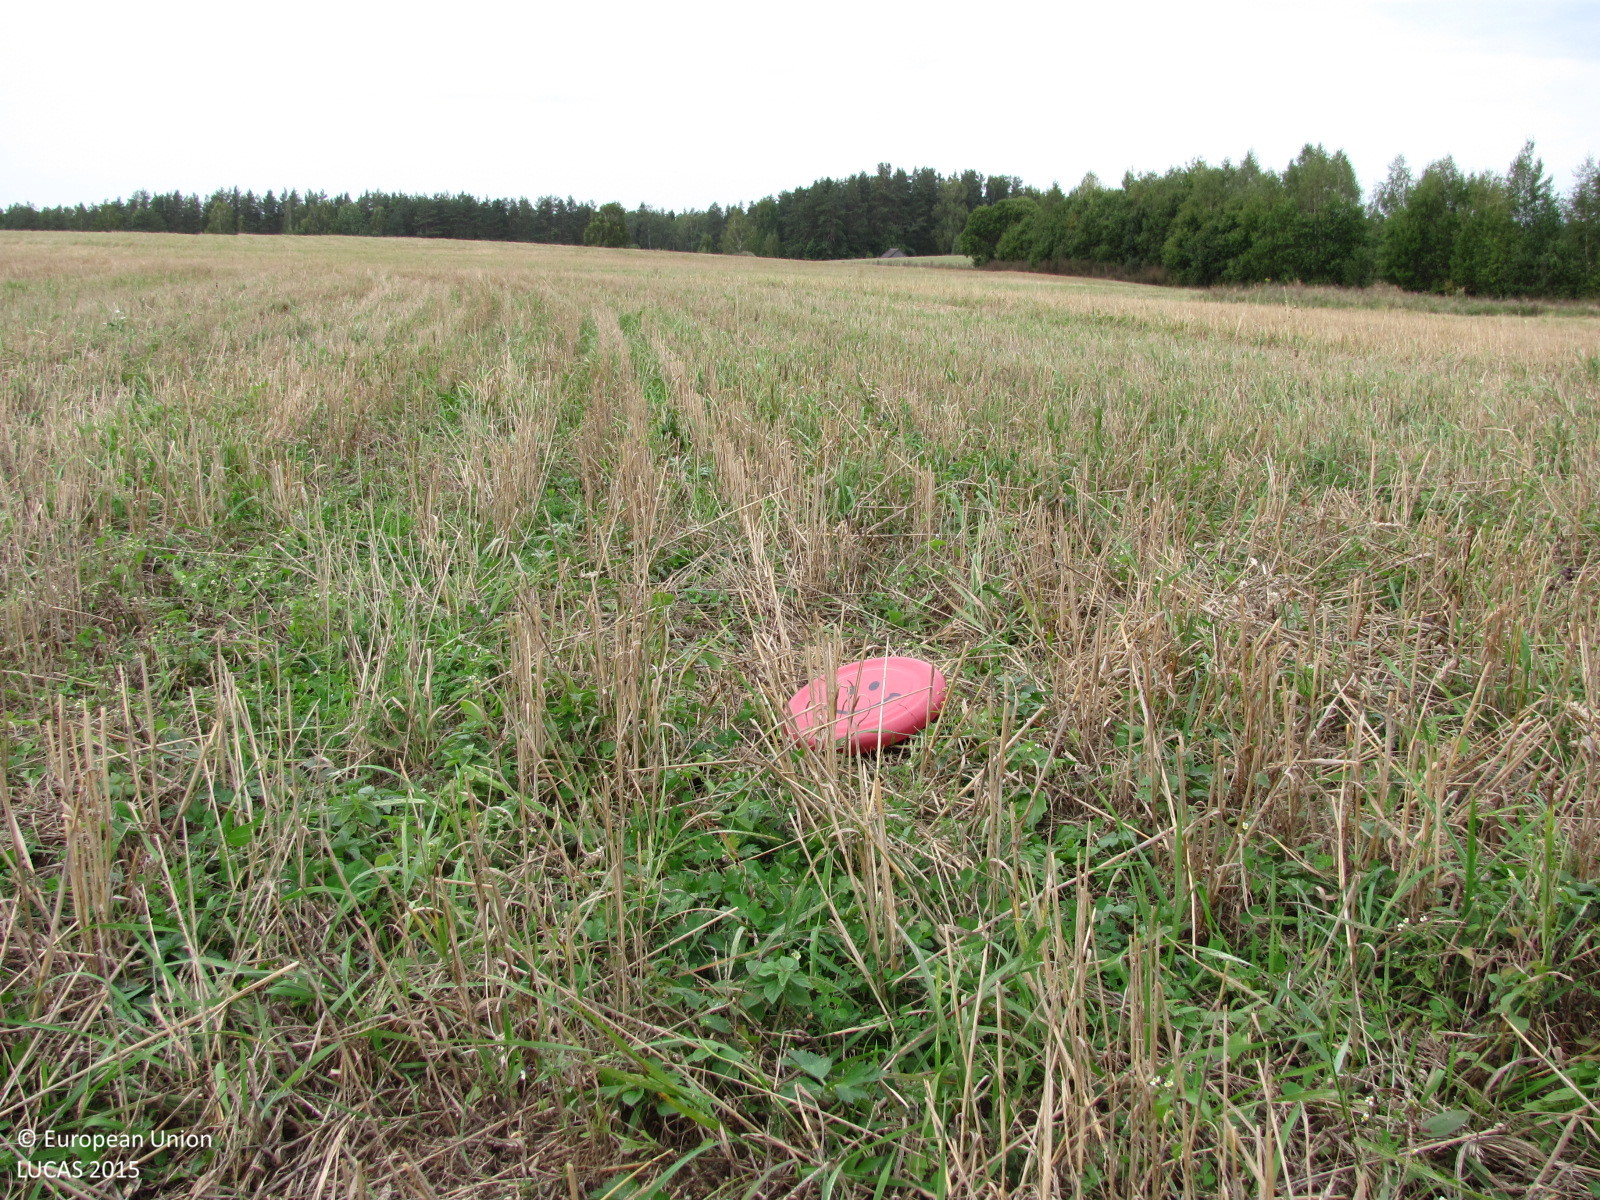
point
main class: Cropland
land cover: Common wheat
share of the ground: 50 - 75 %
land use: Agriculture (excluding fallow land and kitchen gardens)
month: September
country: LV
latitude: 57.1249
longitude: 24.5812
